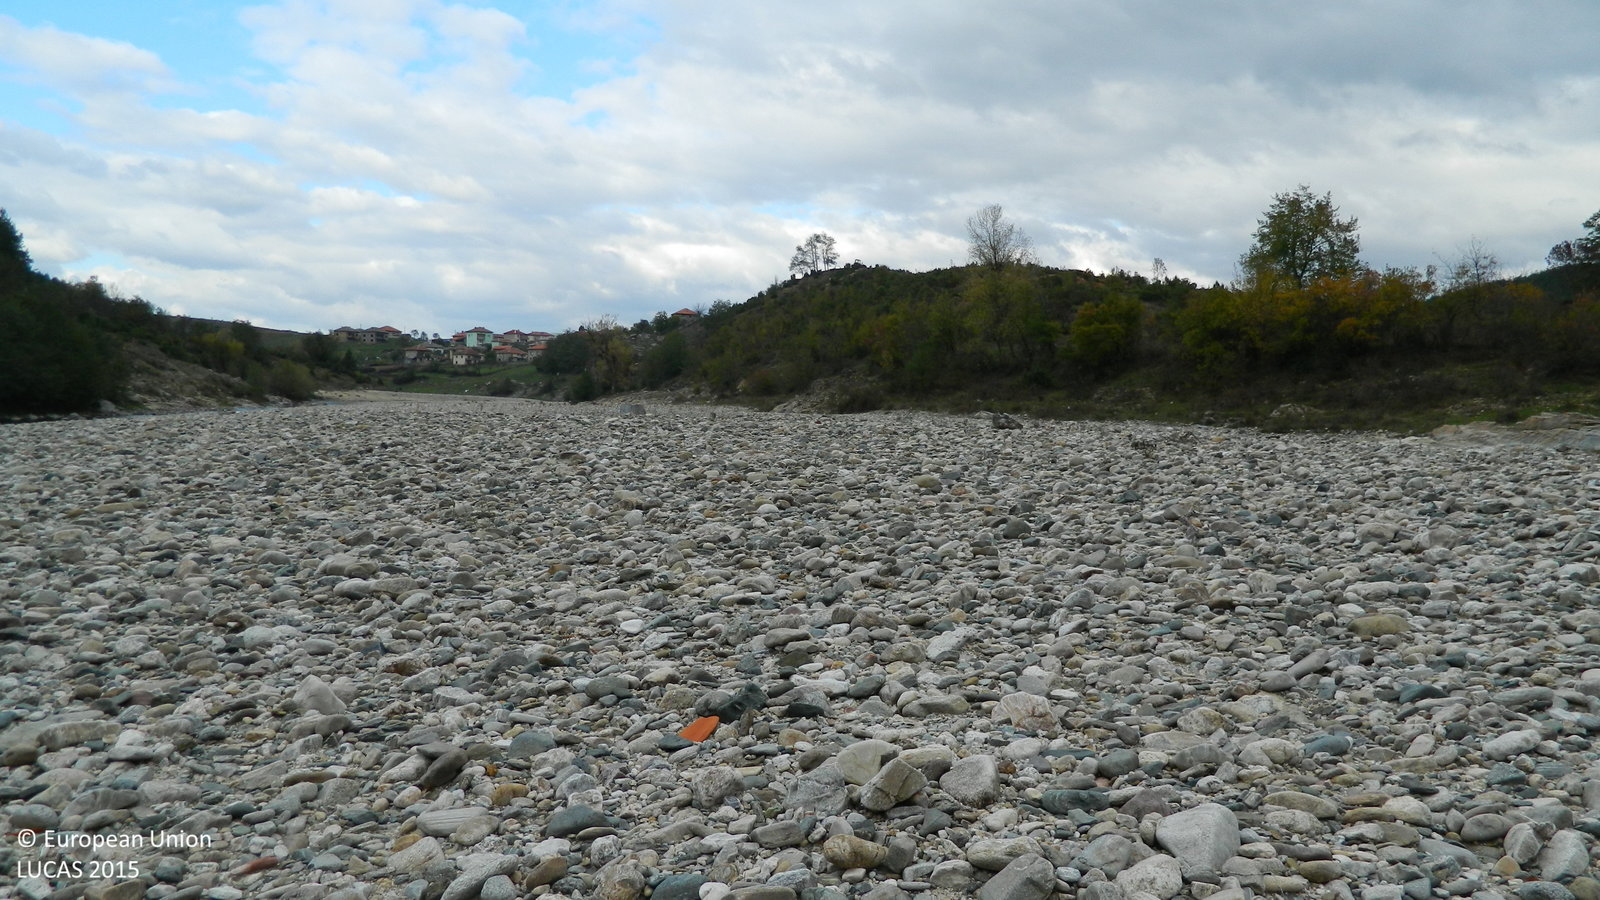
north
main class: Woodland
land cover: Pine dominated coniferous woodland
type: hemiboreal forest and nemoral coniferous forest and mixed broadleaved-coniferous forest
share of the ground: > 75 %
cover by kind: coniferous forest trees 95 %, broadleaved forest trees 5 %
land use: Forestry
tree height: > 5 m
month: October
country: BG
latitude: 41.3601
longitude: 25.2684
